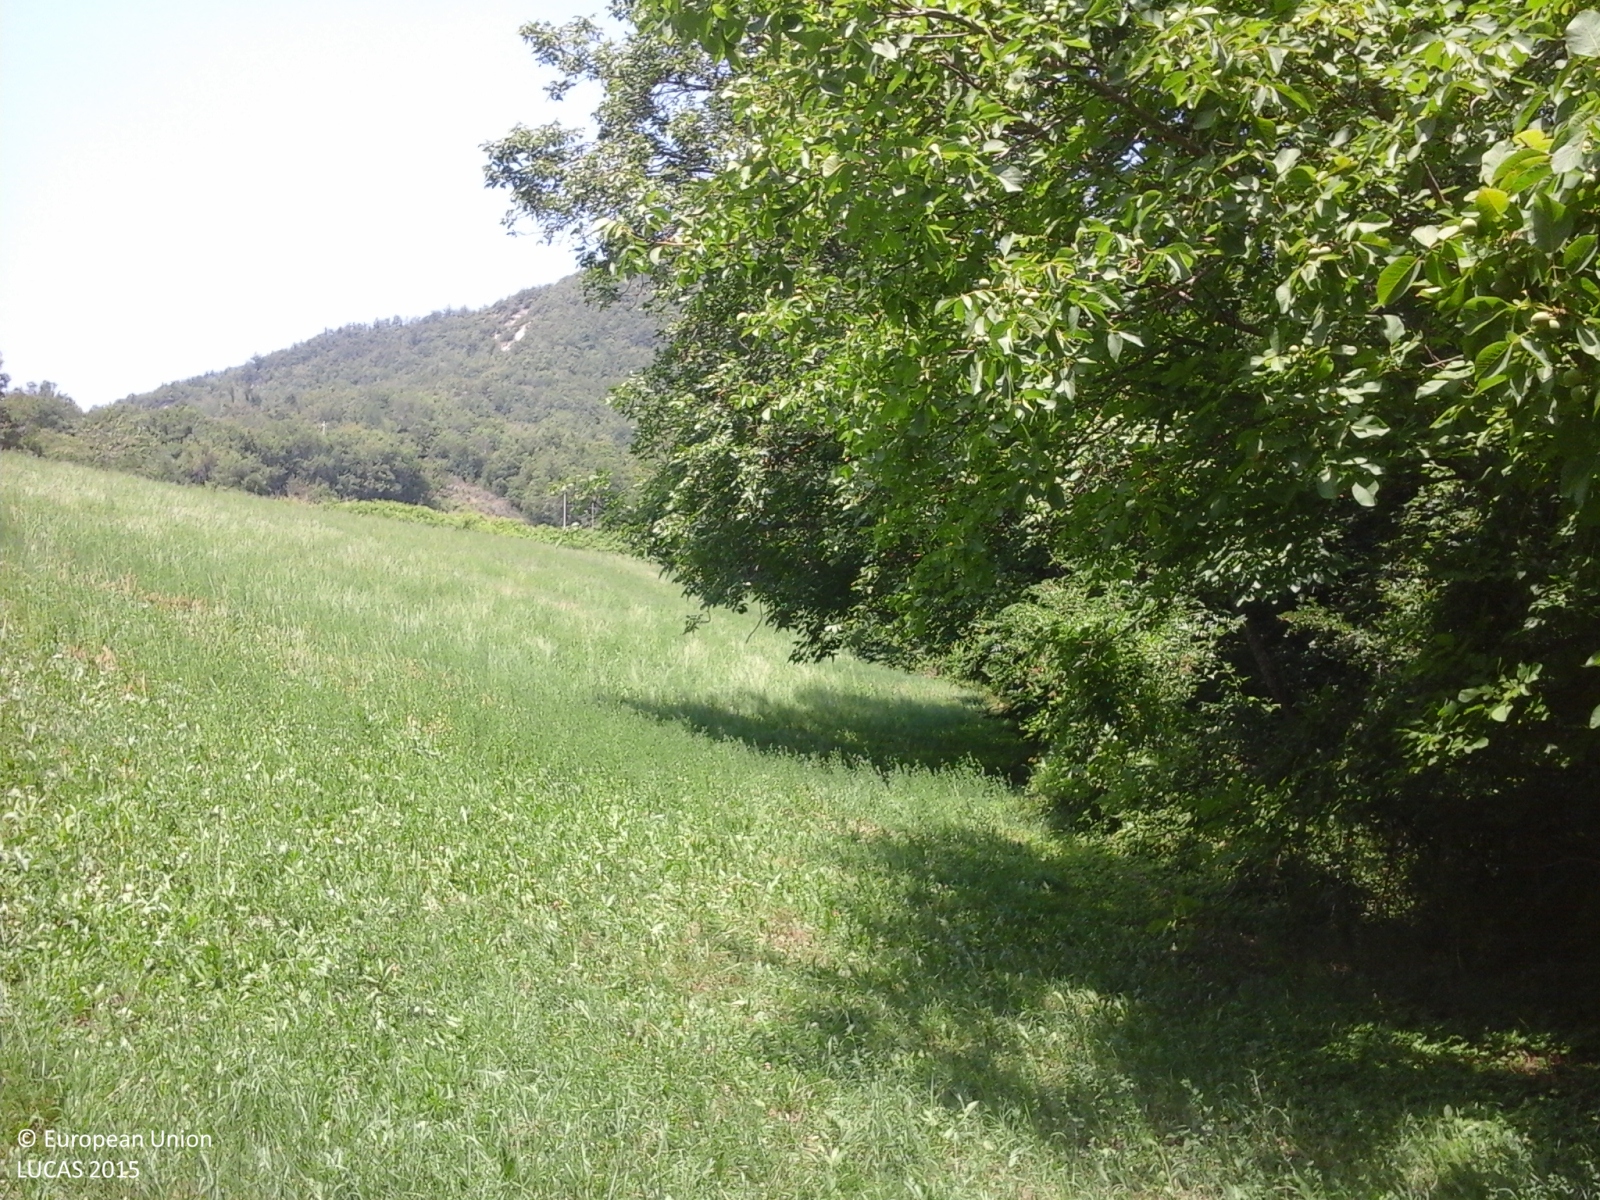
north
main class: Grassland
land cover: Grassland without tree/shrub cover
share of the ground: > 75 %
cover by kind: herbaceous plants 100 %
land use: Agriculture (excluding fallow land and kitchen gardens)
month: July
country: IT
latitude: 44.4764
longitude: 10.2885
